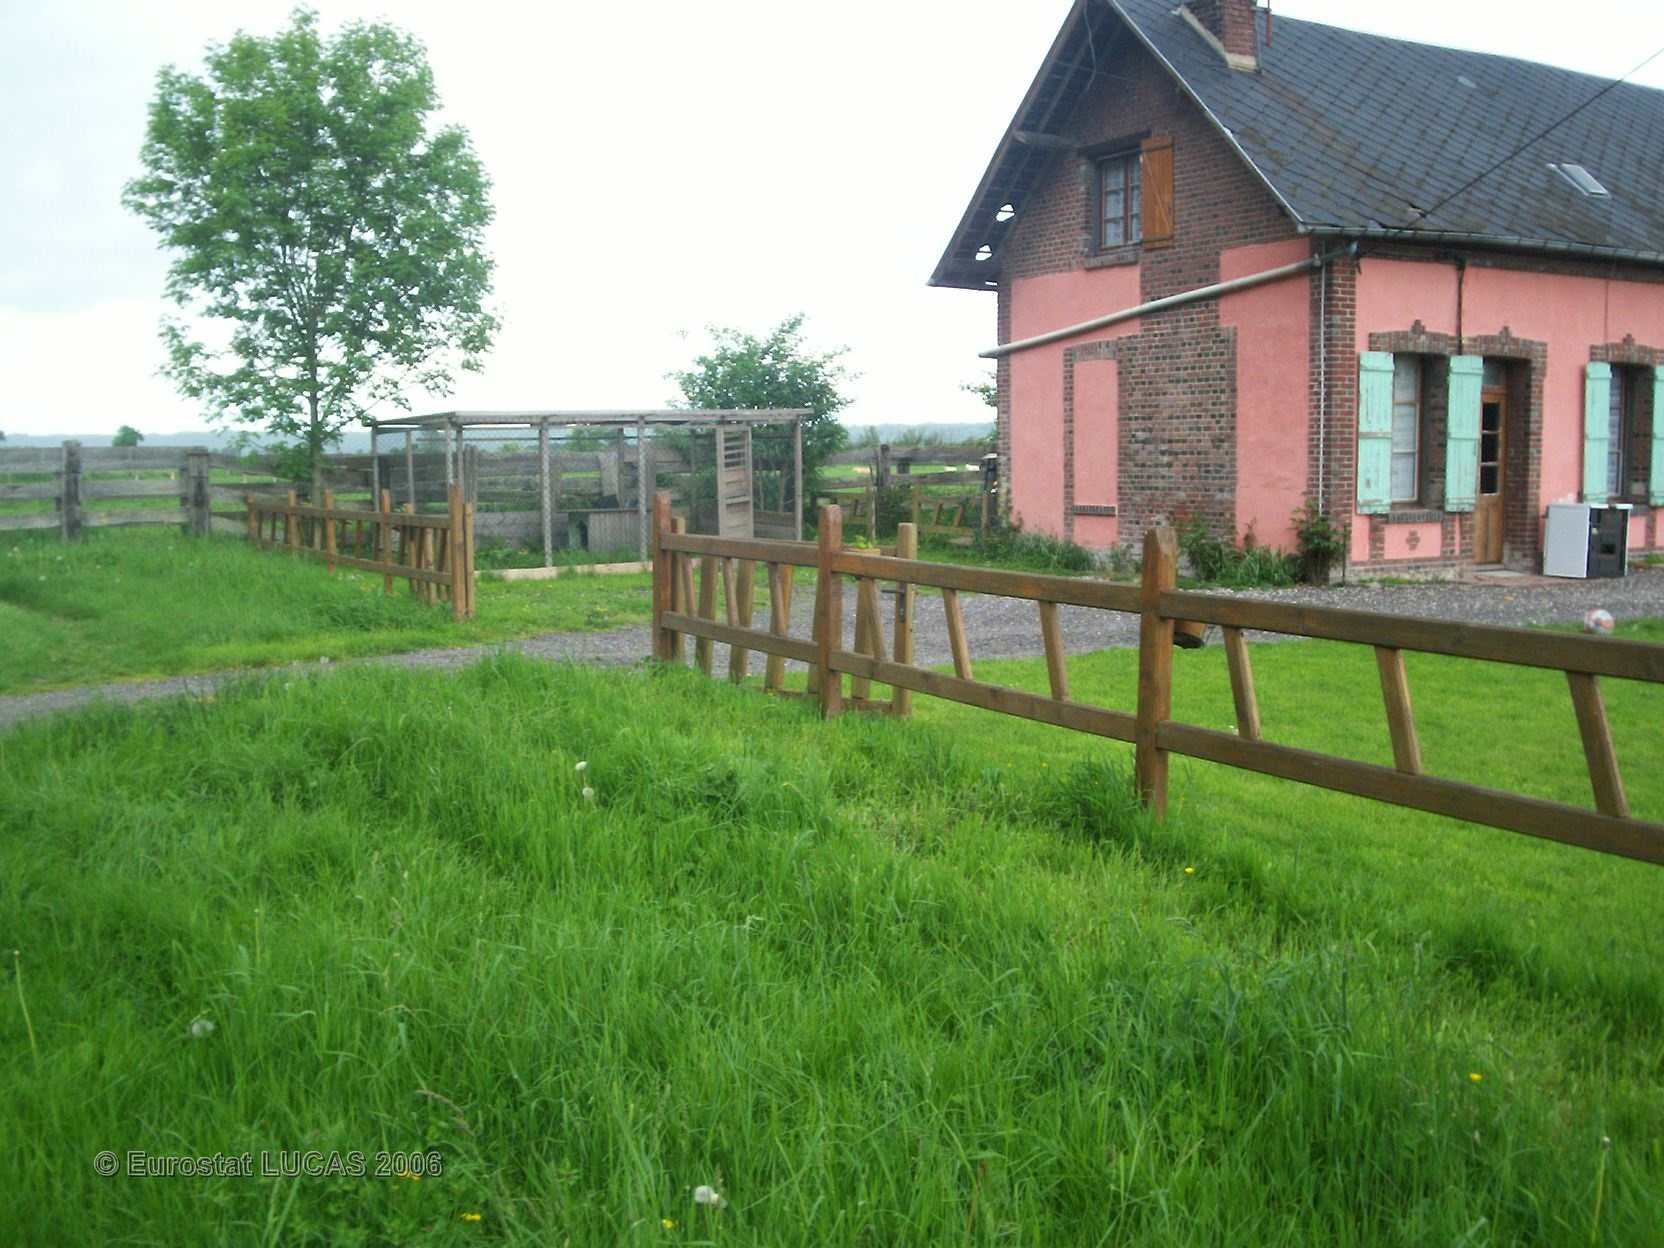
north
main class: Grassland
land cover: Grassland without tree/shrub cover
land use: Agriculture (excluding fallow land and kitchen gardens)
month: May
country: FR
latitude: 49.4379
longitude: 0.4437
